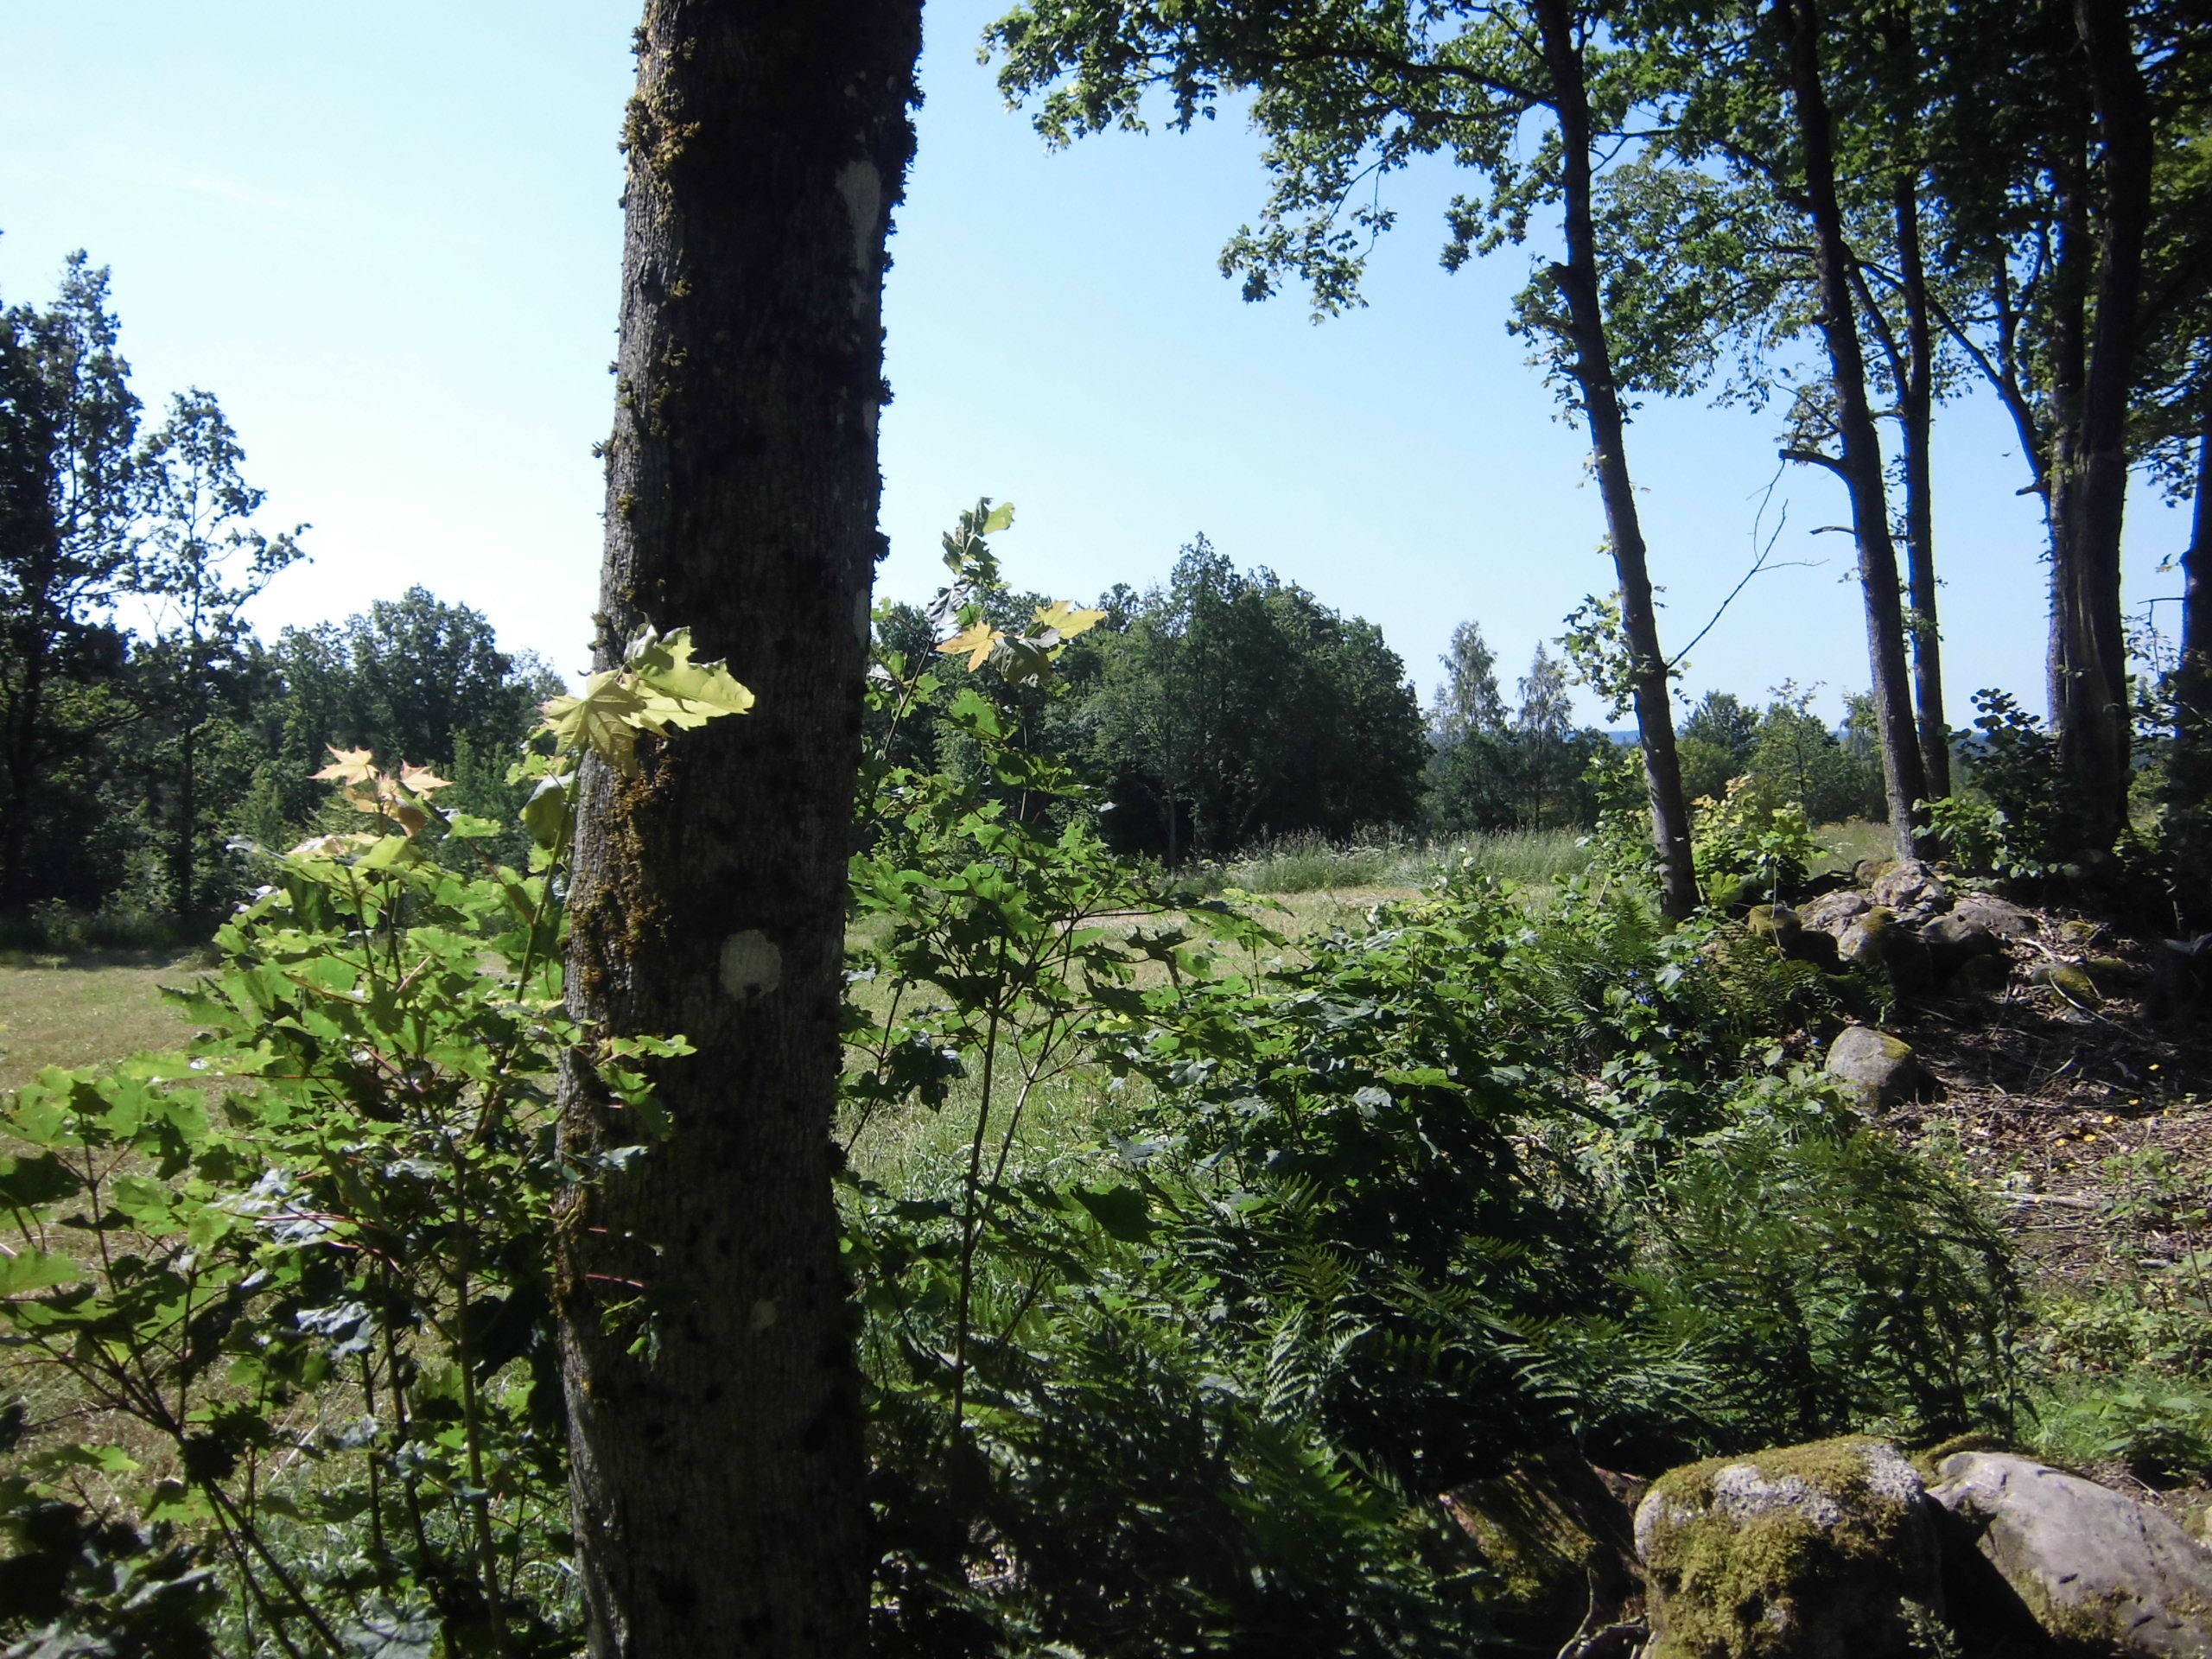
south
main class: Woodland
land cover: Broadleaved woodland
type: hemiboreal forest and nemoral coniferous forest and mixed broadleaved-coniferous forest
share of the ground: 50 - 75 %
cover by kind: broadleaved forest trees 50 %, herbaceous plants 30 %, shrubs 10 %, lichens and mosses 5 %, unconsolidated bare surface 5 %
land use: Semi-natural and natural areas not in use
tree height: > 5 m
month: July
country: SE
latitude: 57.2347
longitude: 14.7512
